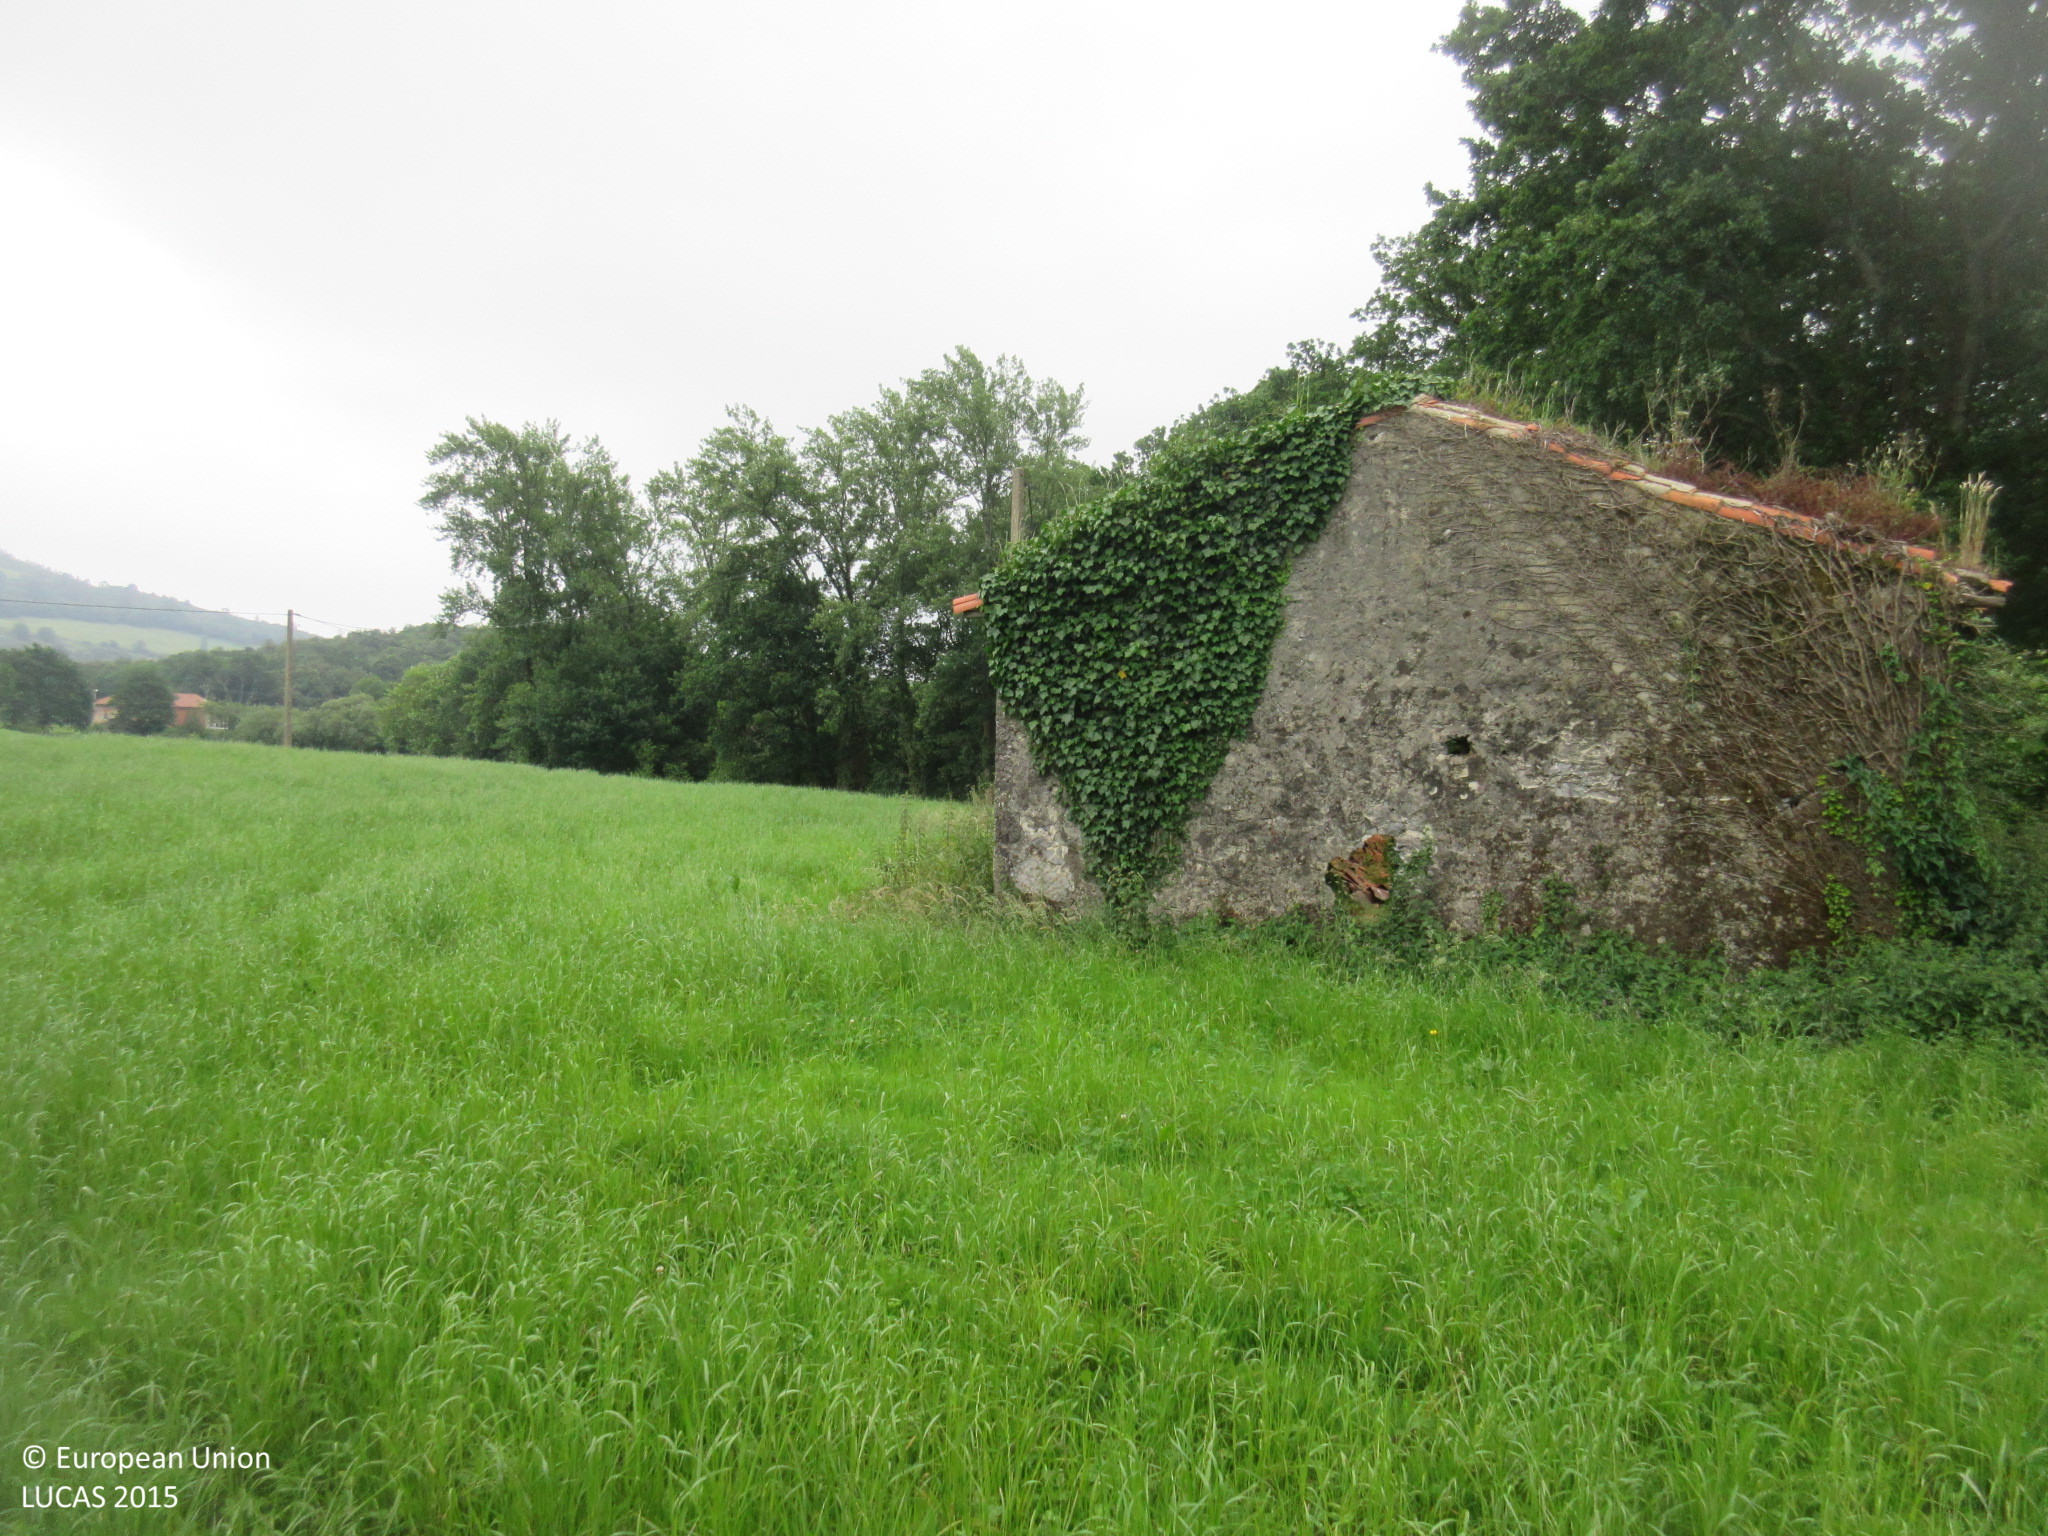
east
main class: Grassland
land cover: Grassland without tree/shrub cover
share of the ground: > 75 %
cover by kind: herbaceous plants 100 %
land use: Agriculture (excluding fallow land and kitchen gardens)
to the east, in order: Grassland without tree/shrub cover; Artificial constructions in urban areas; Grassland without tree/shrub cover; Broadleaved woodland; Inland fresh running water; Broadleaved woodland; Grassland without tree/shrub cover; Broadleaved woodland; Grassland without tree/shrub cover; Broadleaved woodland; Grassland without tree/shrub cover; Dry stone walls; Grassland without tree/shrub cover; Dry stone walls; Grassland without tree/shrub cover; Dry stone walls; Tracks; Dry stone walls; Grassland without tree/shrub cover
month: June
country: ES
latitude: 43.3504
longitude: -3.5281
